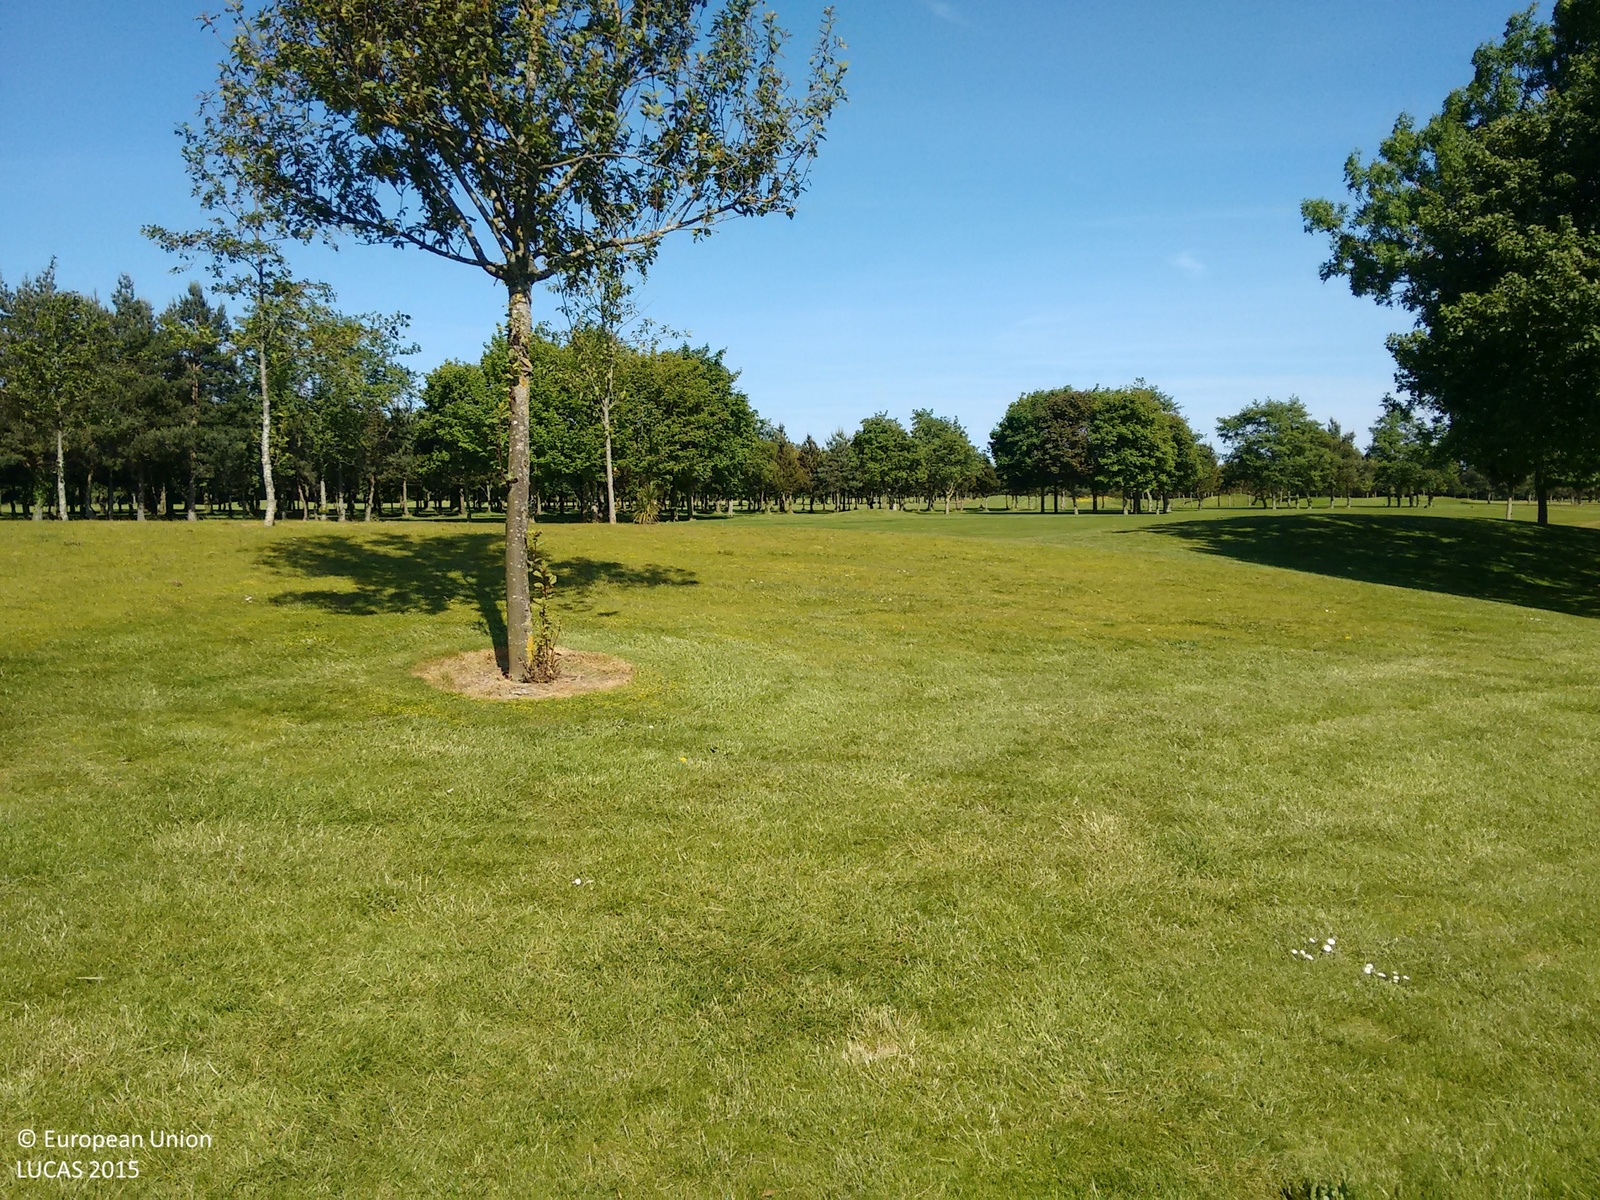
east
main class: Grassland
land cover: Grassland with sparse tree/shrub cover
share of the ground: > 75 %
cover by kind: herbaceous plants 90 %, broadleaved forest trees 5 %, shrubs 5 %
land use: Sport
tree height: < 5 m
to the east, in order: Grassland with sparse tree/shrub cover; Single bushes/trees; Lines of trees; Grassland with sparse tree/shrub cover; Grassland without tree/shrub cover; Lines of trees; Grassland without tree/shrub cover; Other mixed woodland; Grassland without tree/shrub cover
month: June
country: IE
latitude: 53.4860
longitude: -6.2602
